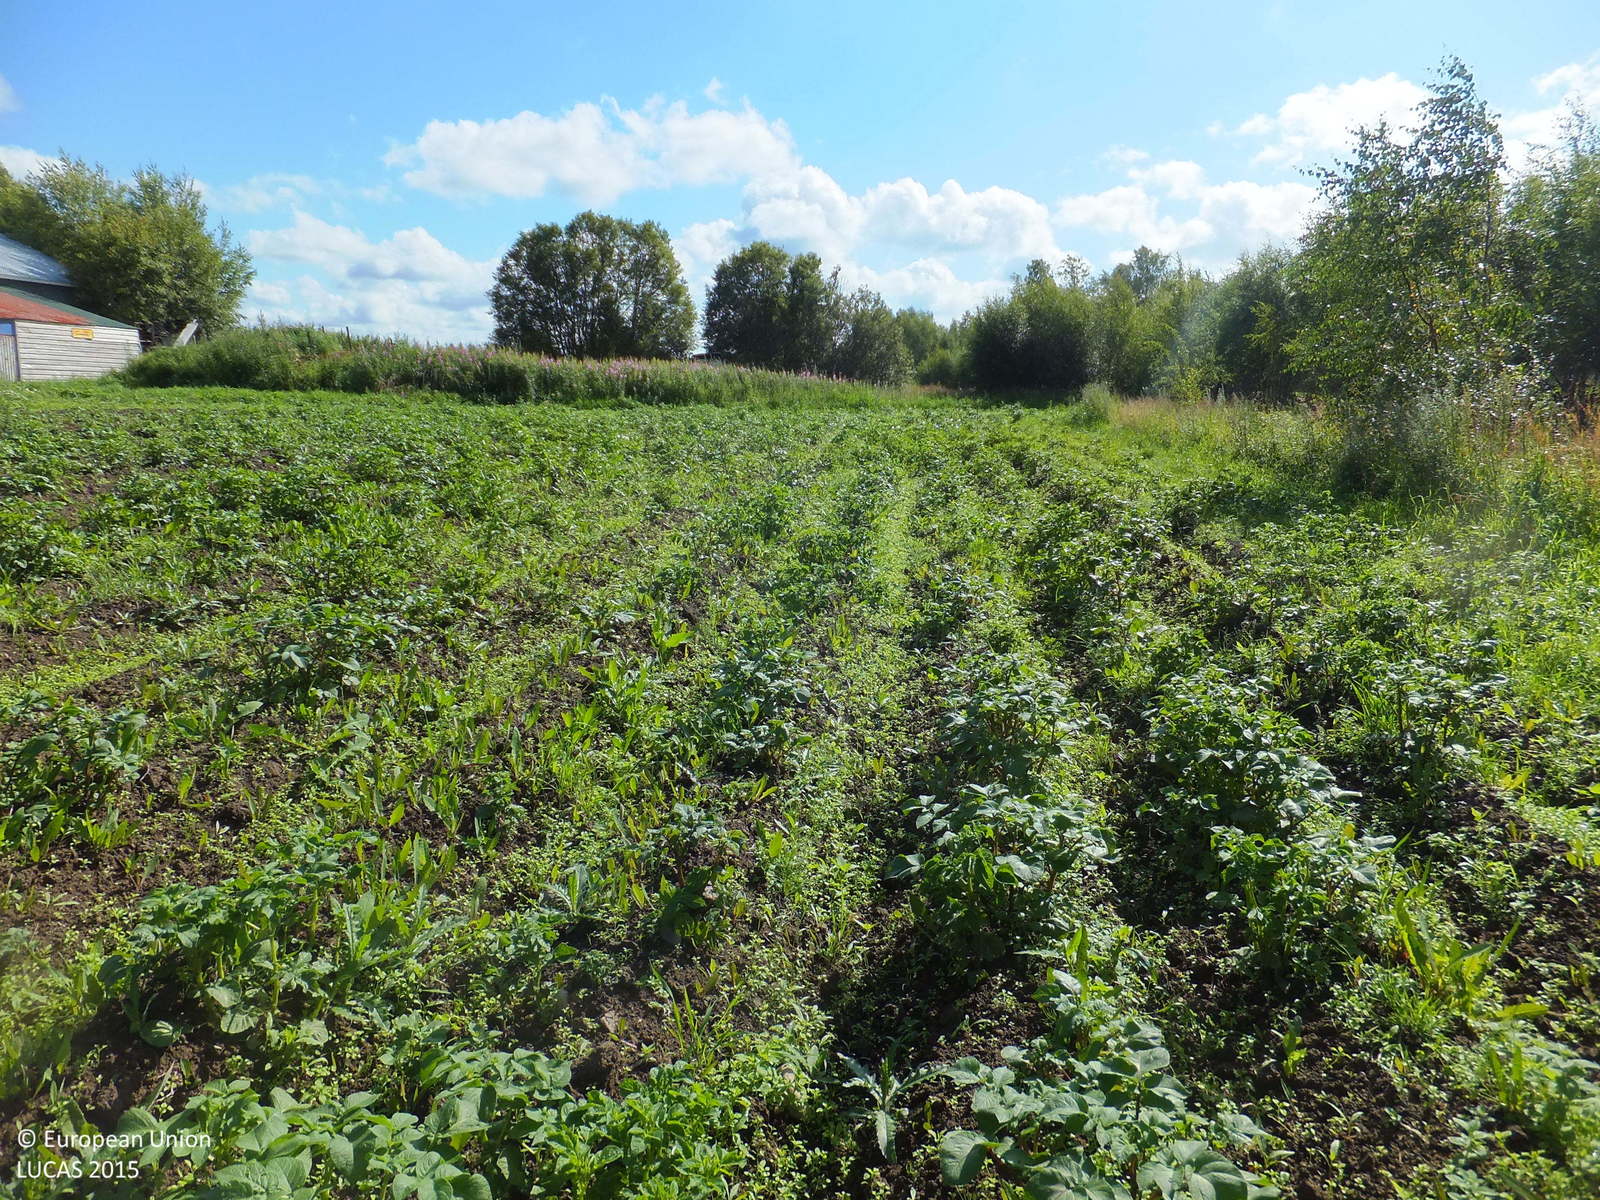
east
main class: Cropland
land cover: Potatoes
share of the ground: 25 - 50 %
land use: Agriculture (excluding fallow land and kitchen gardens)
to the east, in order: Potatoes; Tracks; Grassland without tree/shrub cover; Lines of trees; Oats; Grass margins; Ditches and canals; Grass margins; Temporary grasslands; Ditches and canals; Broadleaved woodland; Ditches and canals; Broadleaved woodland; Ditches and canals
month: July
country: FI
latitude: 63.1836
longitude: 21.6227
